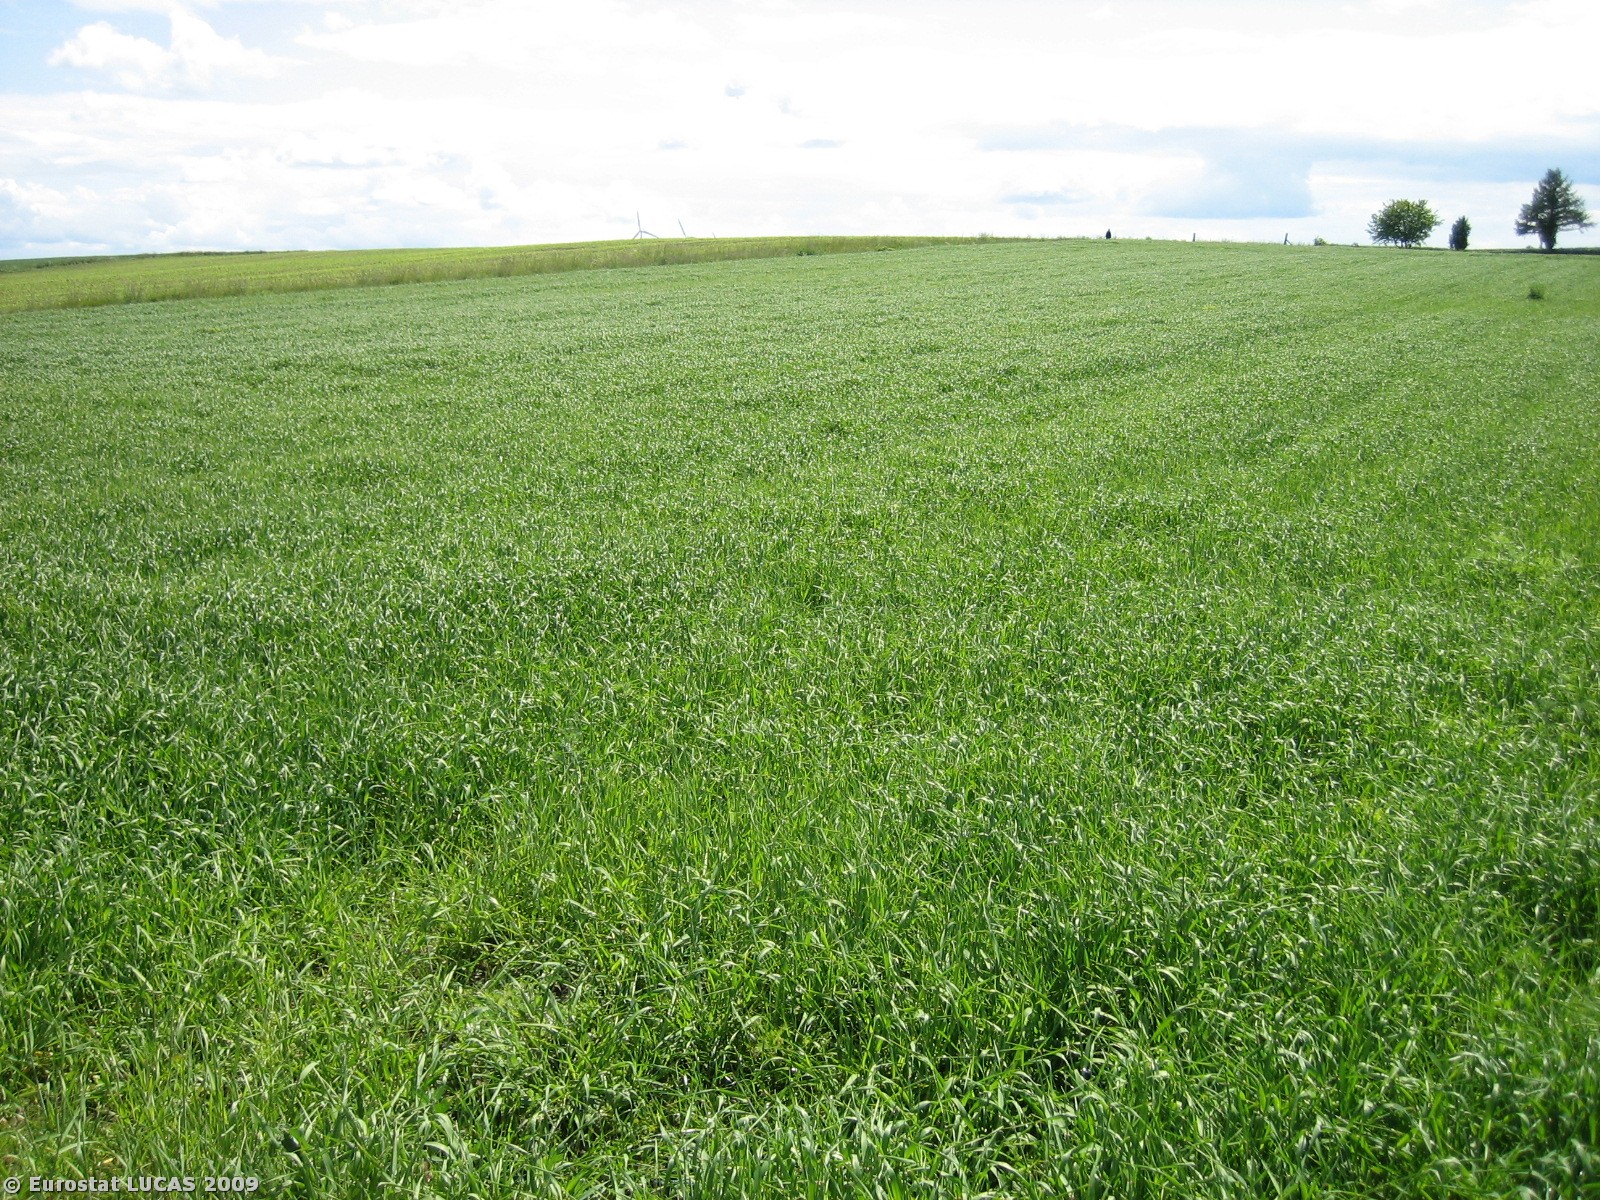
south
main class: Cropland
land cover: Barley
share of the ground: > 75 %
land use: Agriculture (excluding fallow land and kitchen gardens)
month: June
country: DK
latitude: 56.2954
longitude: 9.7902
